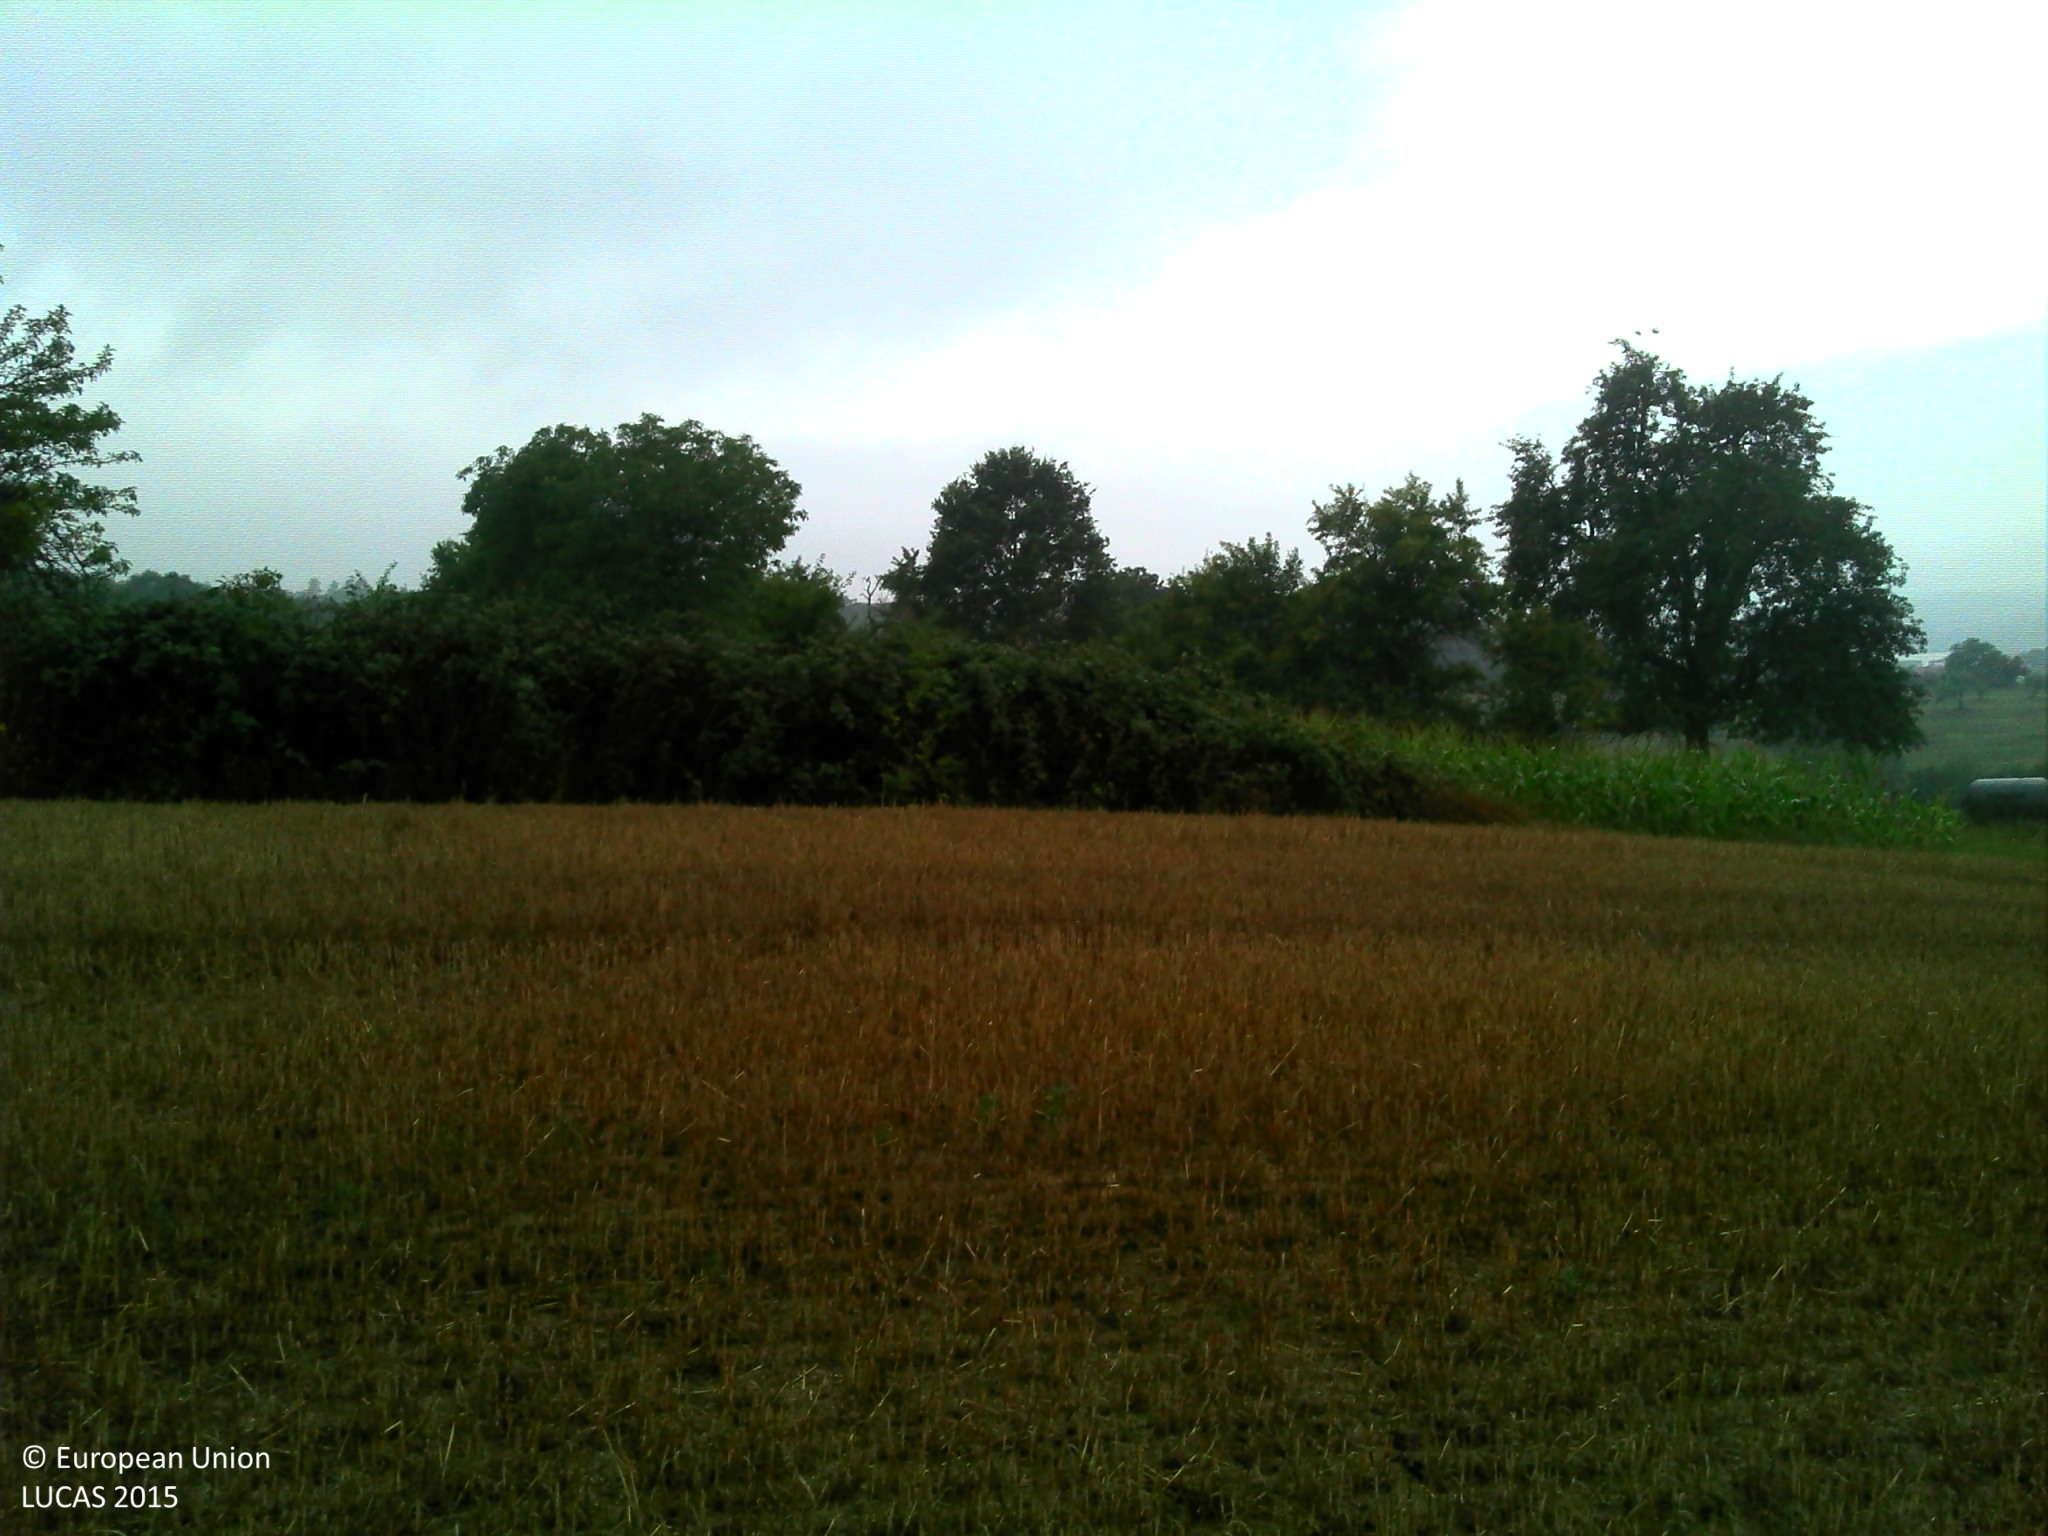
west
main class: Cropland
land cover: Triticale
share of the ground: 50 - 75 %
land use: Agriculture (excluding fallow land and kitchen gardens)
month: August
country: FR
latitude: 48.8608
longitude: 7.4790
